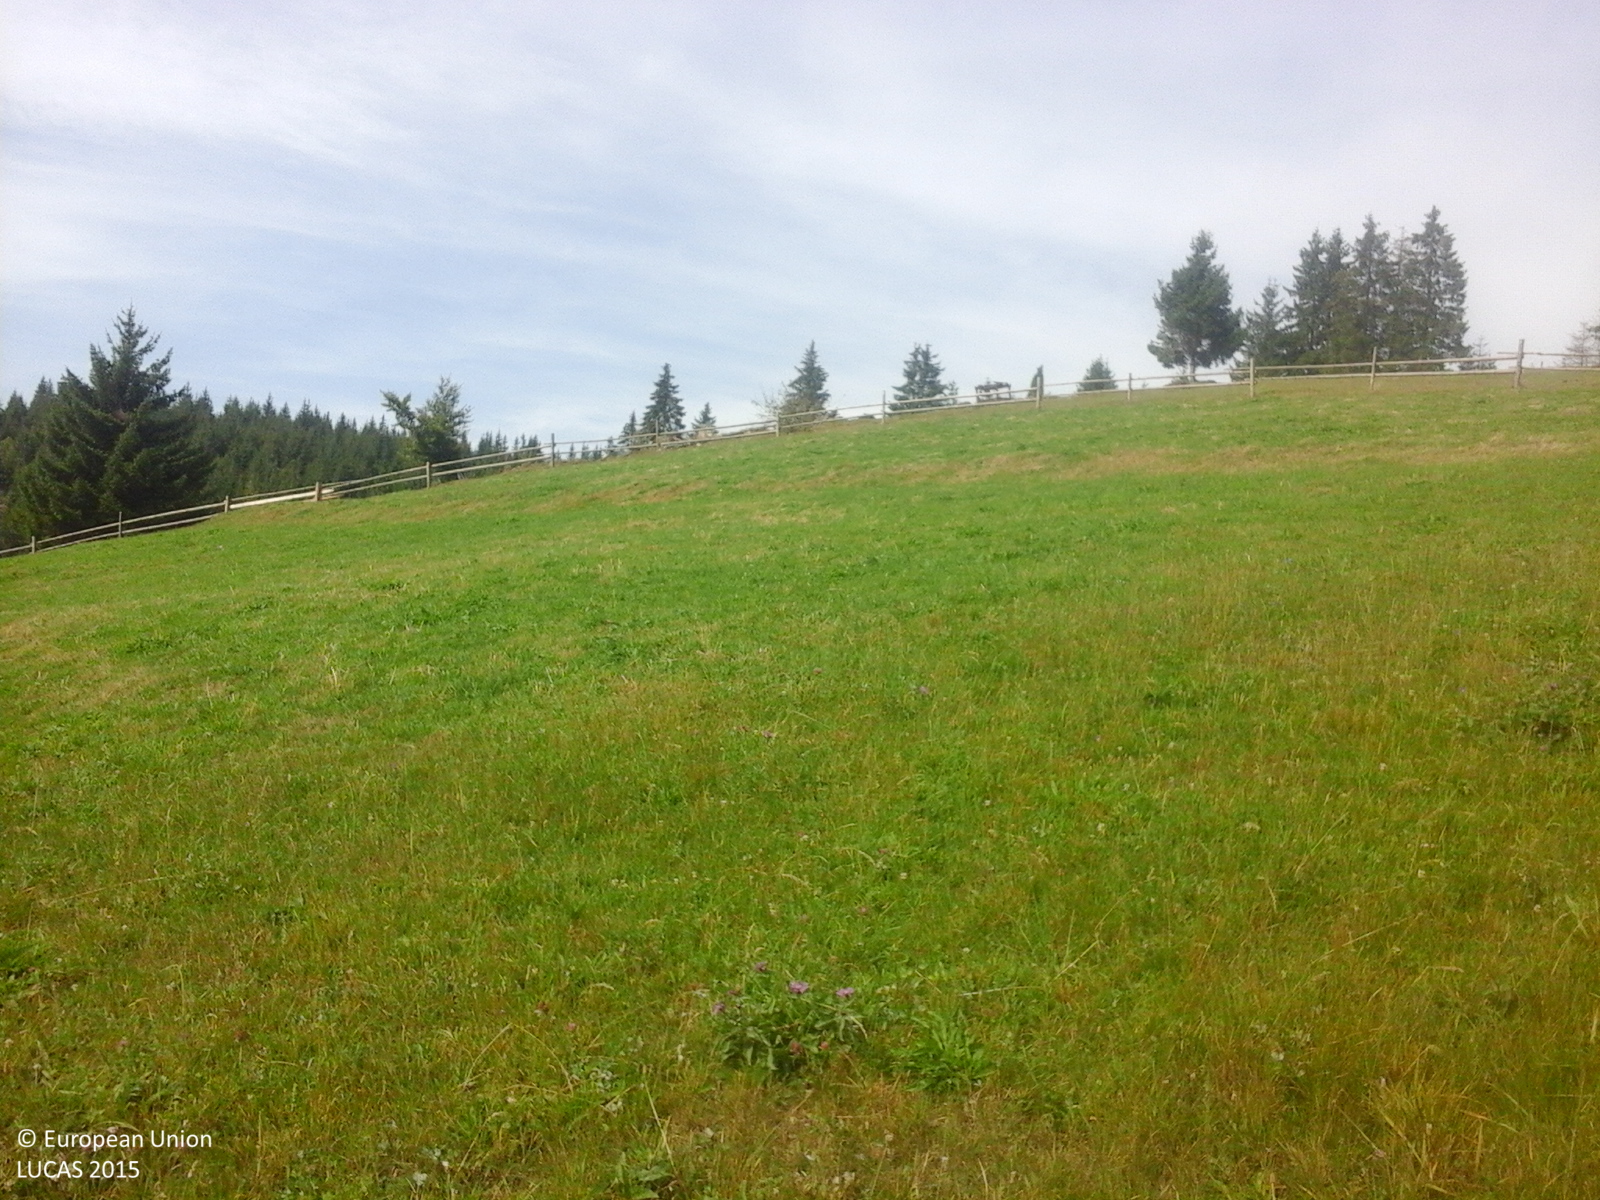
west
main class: Grassland
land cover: Grassland without tree/shrub cover
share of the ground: > 75 %
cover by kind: herbaceous plants 100 %
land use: Agriculture (excluding fallow land and kitchen gardens)
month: September
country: RO
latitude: 46.6328
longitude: 23.2703
